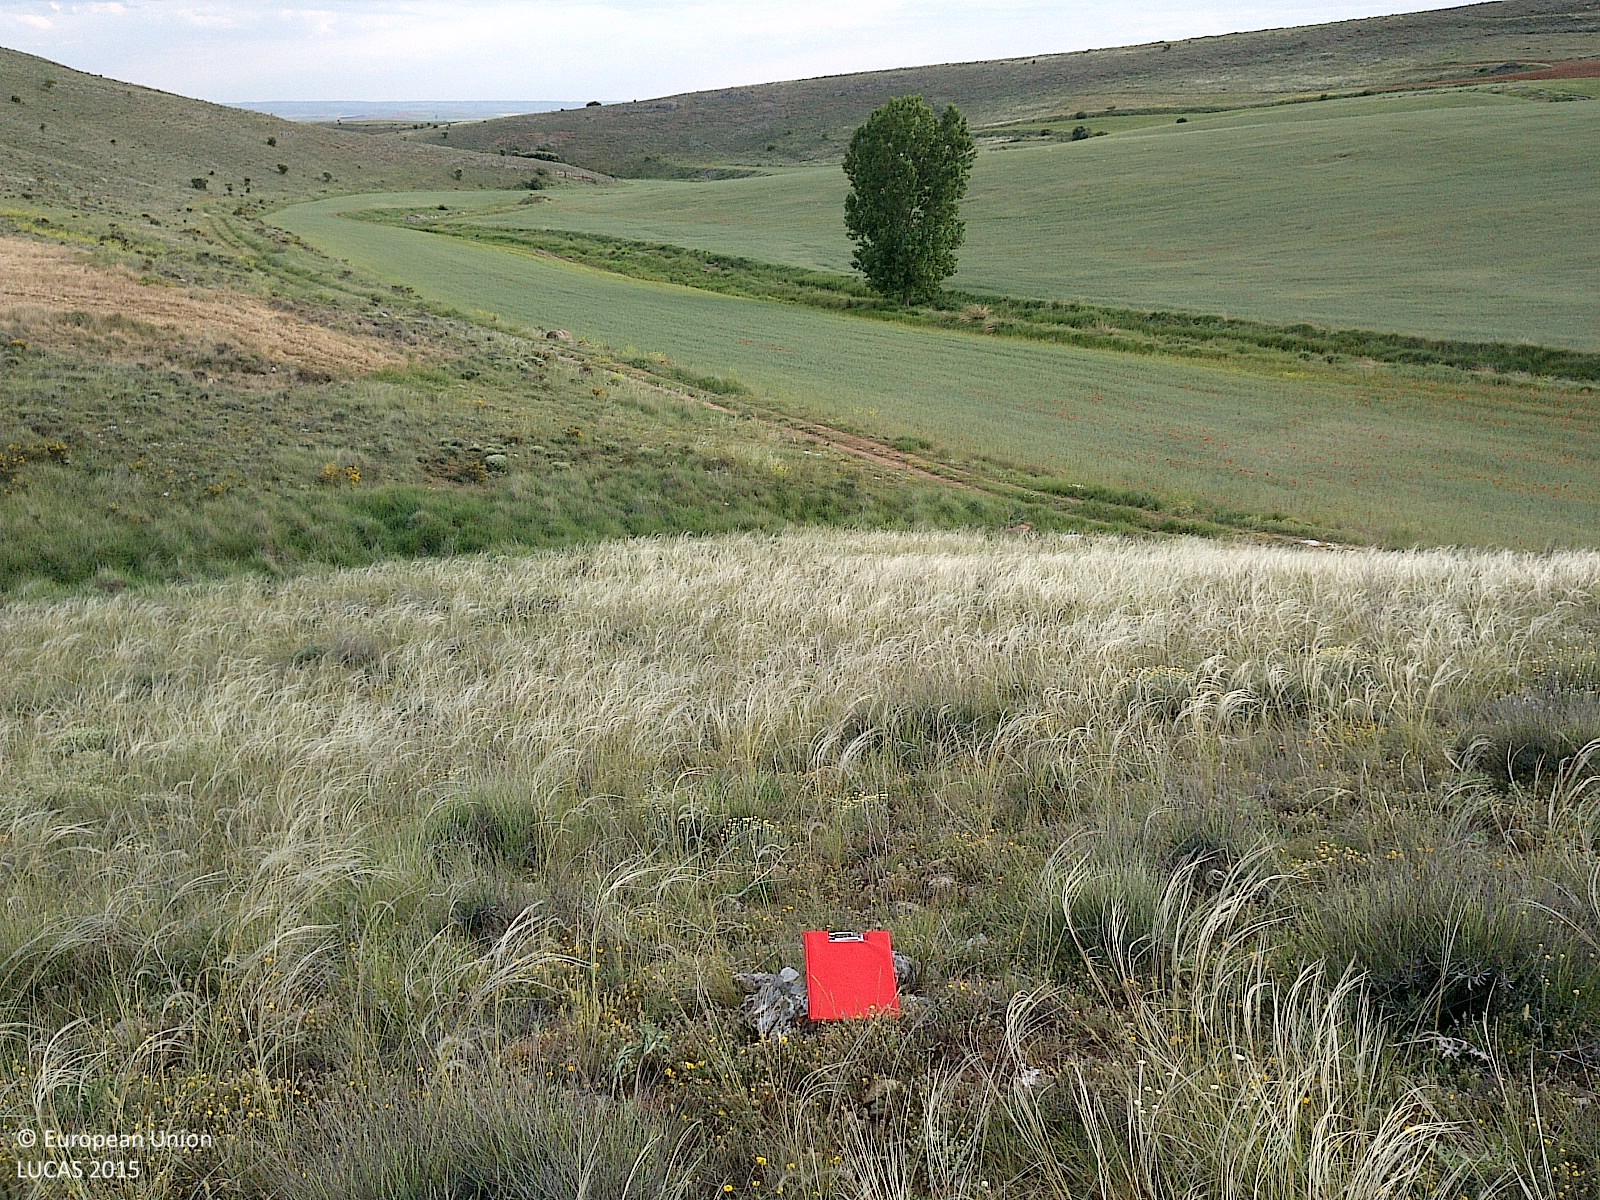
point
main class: Grassland
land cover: Grassland without tree/shrub cover
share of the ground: > 75 %
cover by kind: herbaceous plants 80 %, unconsolidated bare surface 10 %, shrubs 5 %, consolidated bare surface 5 %
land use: Semi-natural and natural areas not in use
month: June
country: ES
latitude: 41.7385
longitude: -2.2878
